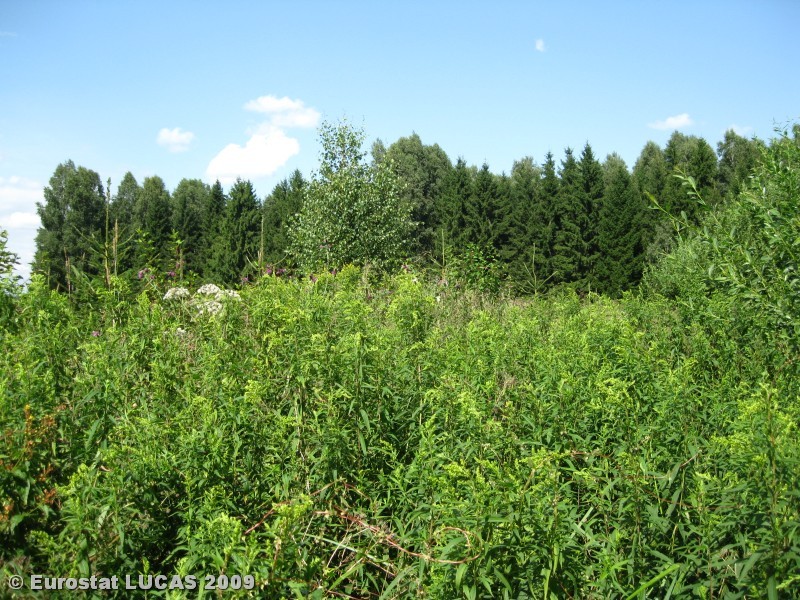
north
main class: Woodland
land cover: Mixed woodland
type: hemiboreal forest and nemoral coniferous forest and mixed broadleaved-coniferous forest
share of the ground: > 75 %
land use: Forestry
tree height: > 5 m
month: August
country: LT
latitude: 54.8611
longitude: 23.5581
